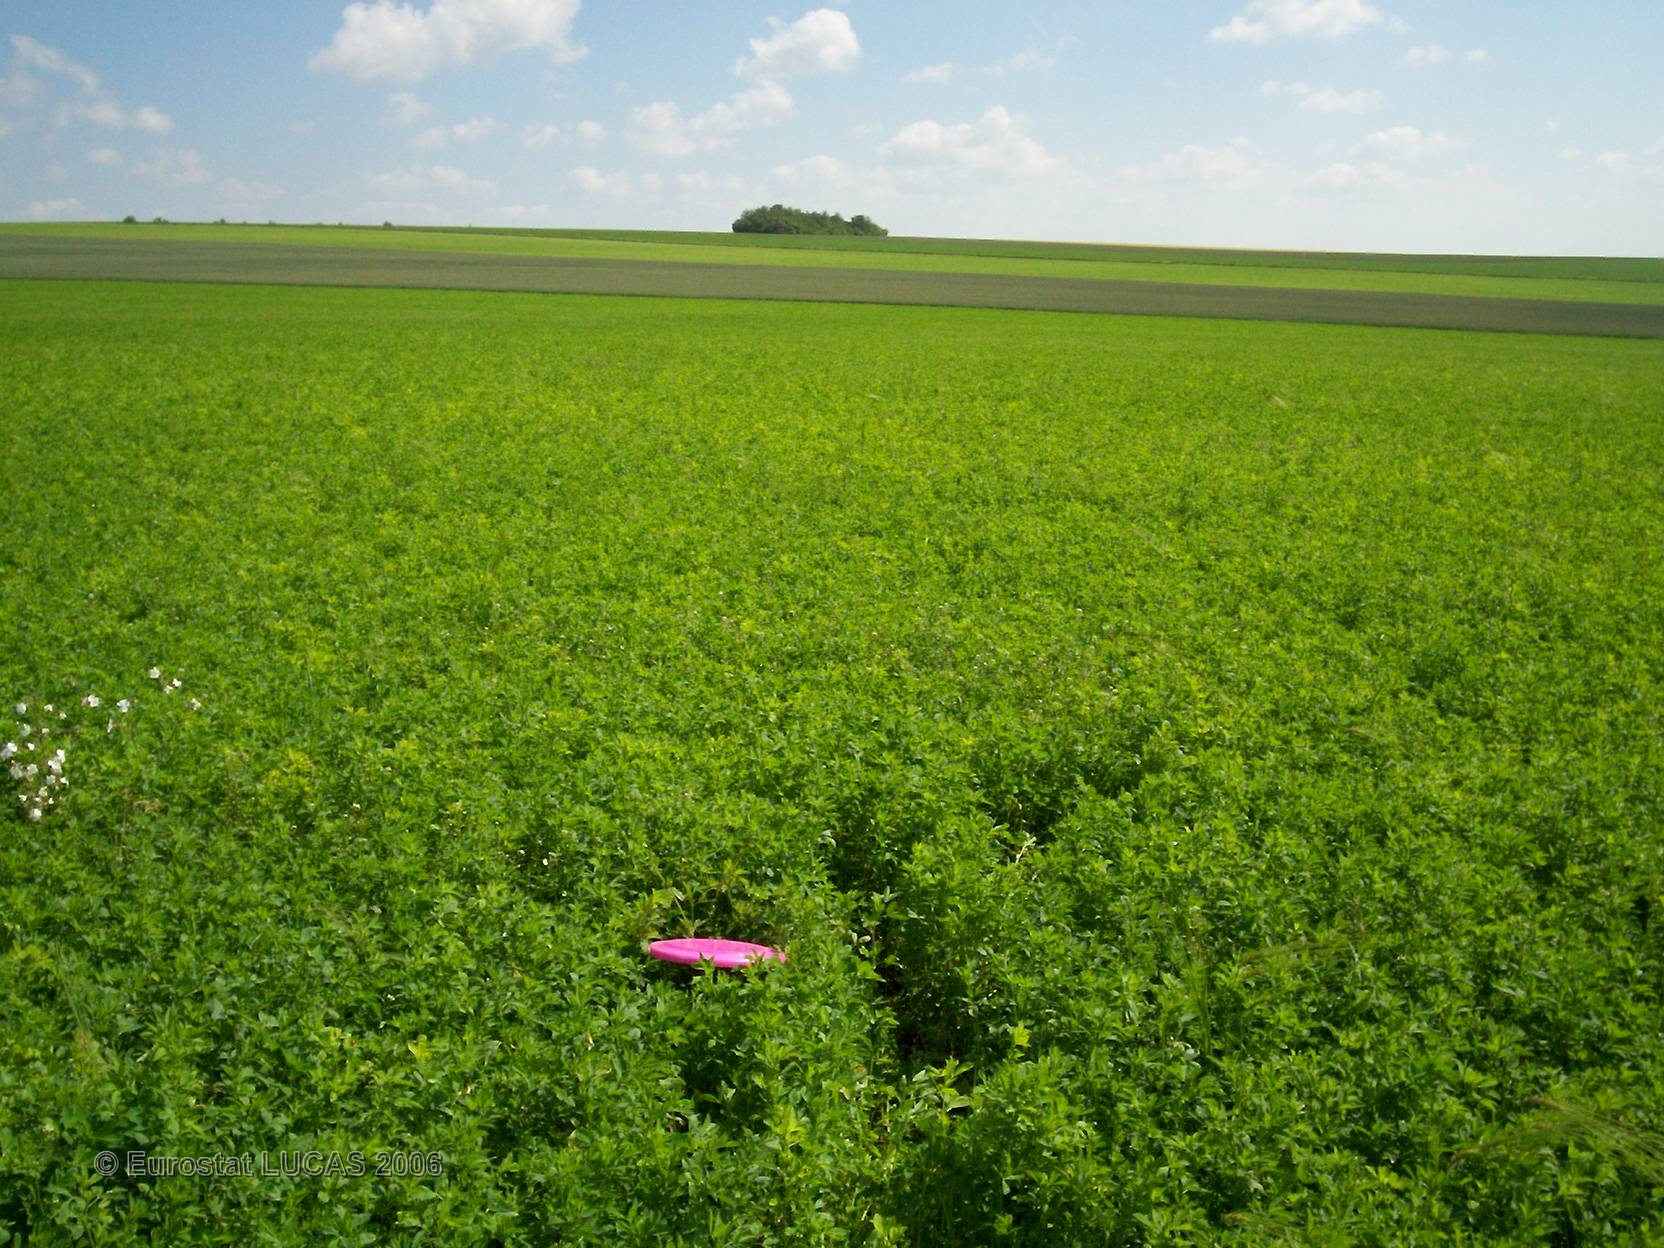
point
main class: Cropland
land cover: Lucerne
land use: Agriculture (excluding fallow land and kitchen gardens)
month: June
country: FR
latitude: 48.8040
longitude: 4.4280
